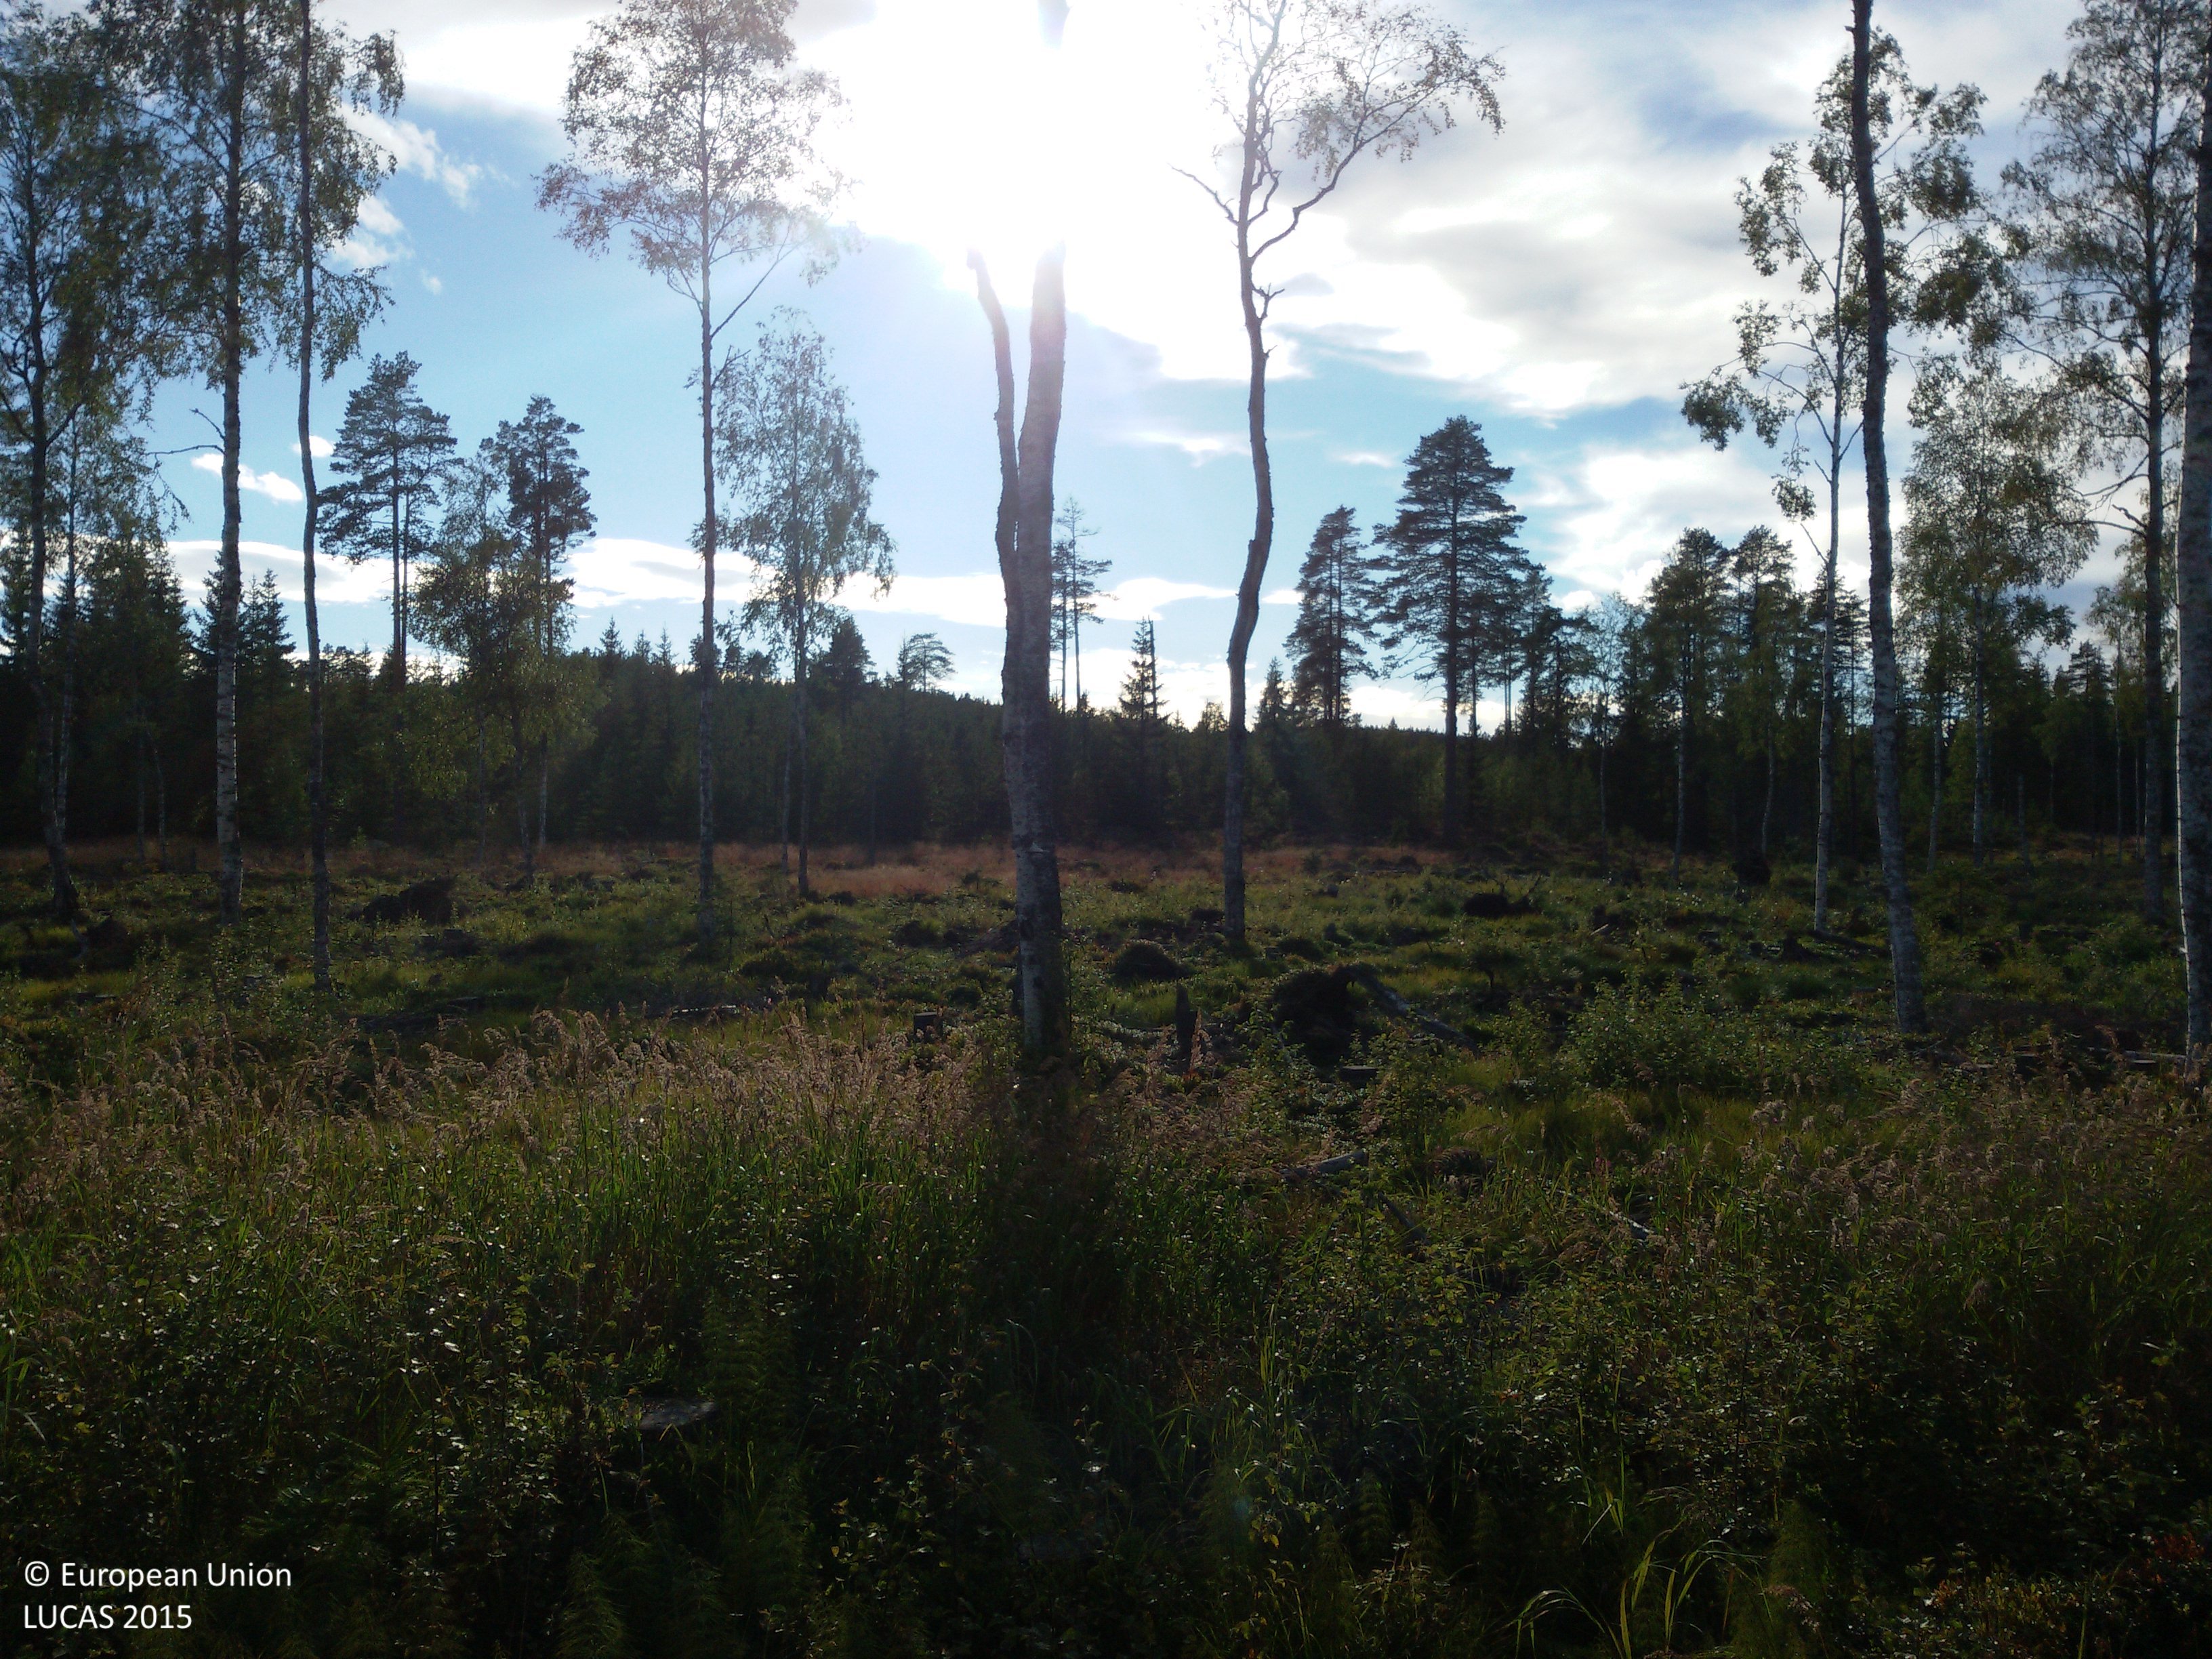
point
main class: Woodland
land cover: Spruce dominated coniferous woodland
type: boreal forest
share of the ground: > 75 %
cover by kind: coniferous forest trees 80 %, herbaceous plants 10 %, lichens and mosses 10 %
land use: Forestry
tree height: > 5 m
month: August
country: SE
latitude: 60.8476
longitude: 16.0043
